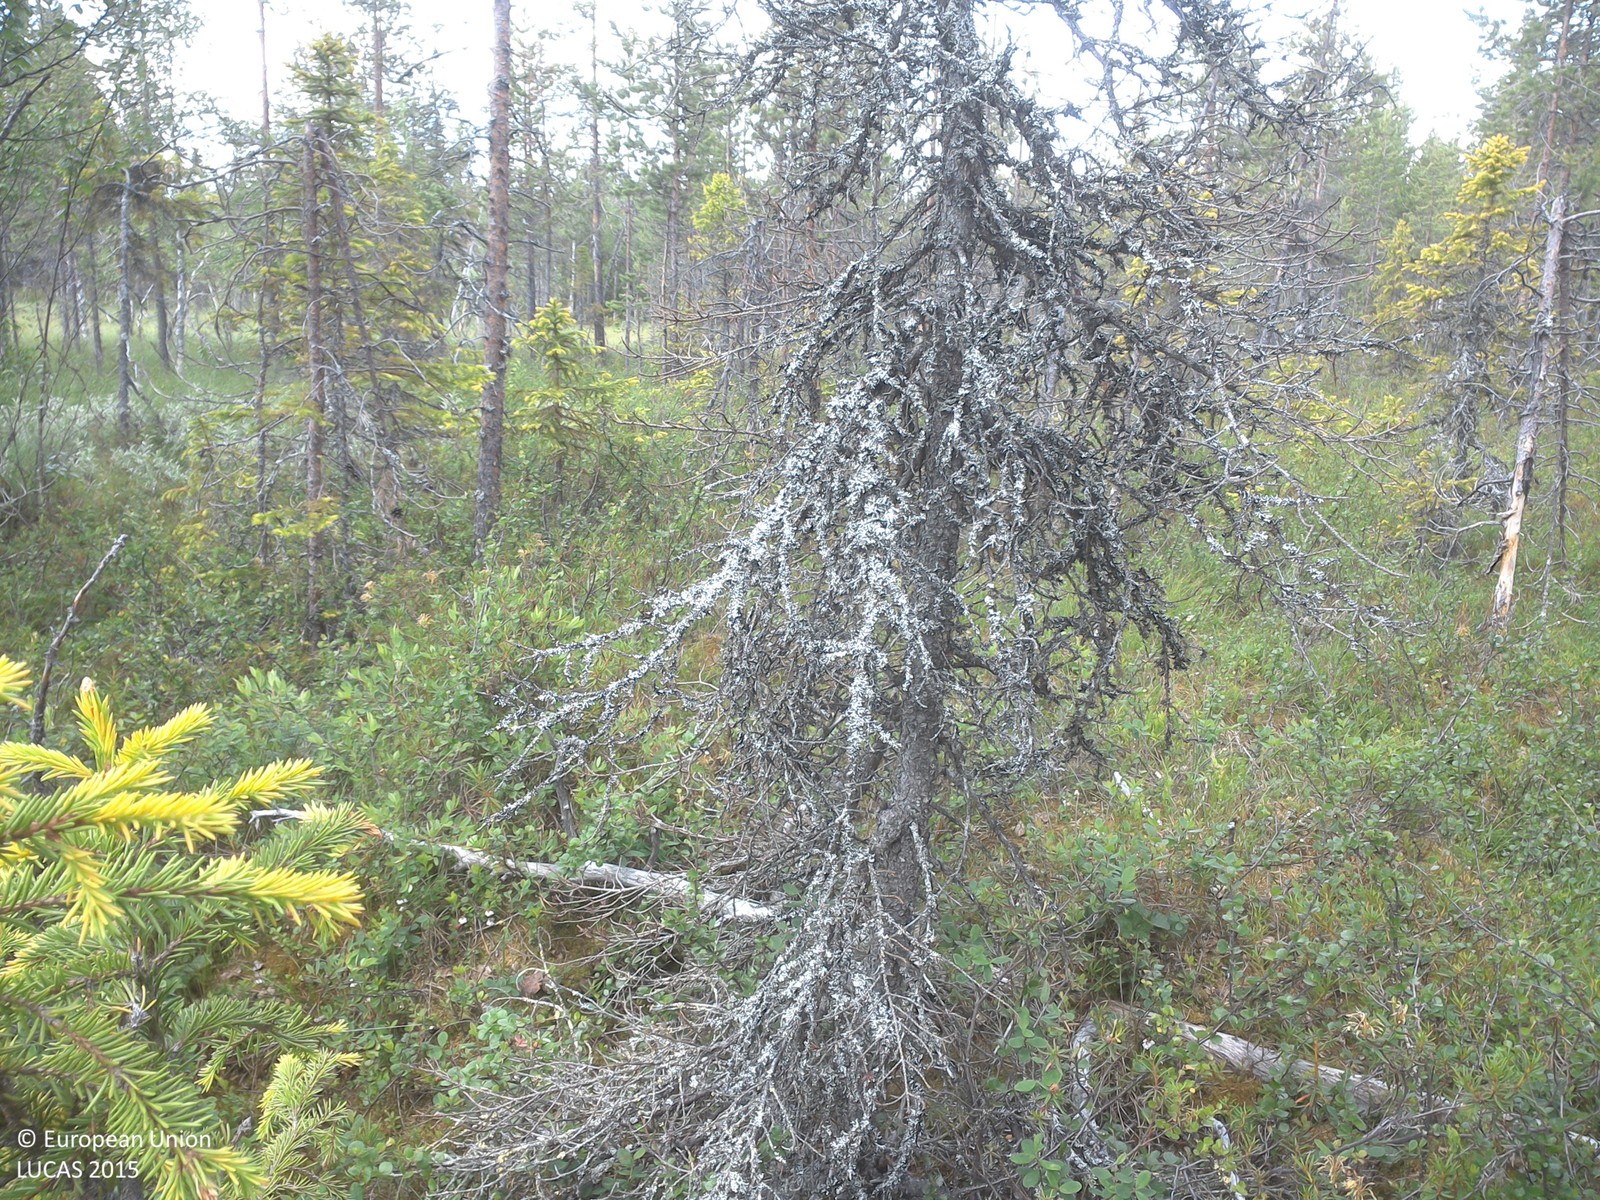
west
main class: Woodland
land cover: Pine dominated mixed woodland
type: boreal forest
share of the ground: 25 - 50 %
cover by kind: herbaceous plants 35 %, shrubs 30 %, coniferous forest trees 20 %, broadleaved forest trees 10 %, lichens and mosses 5 %
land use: Forestry
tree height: > 5 m
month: July
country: SE
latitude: 67.4386
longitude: 23.3512
